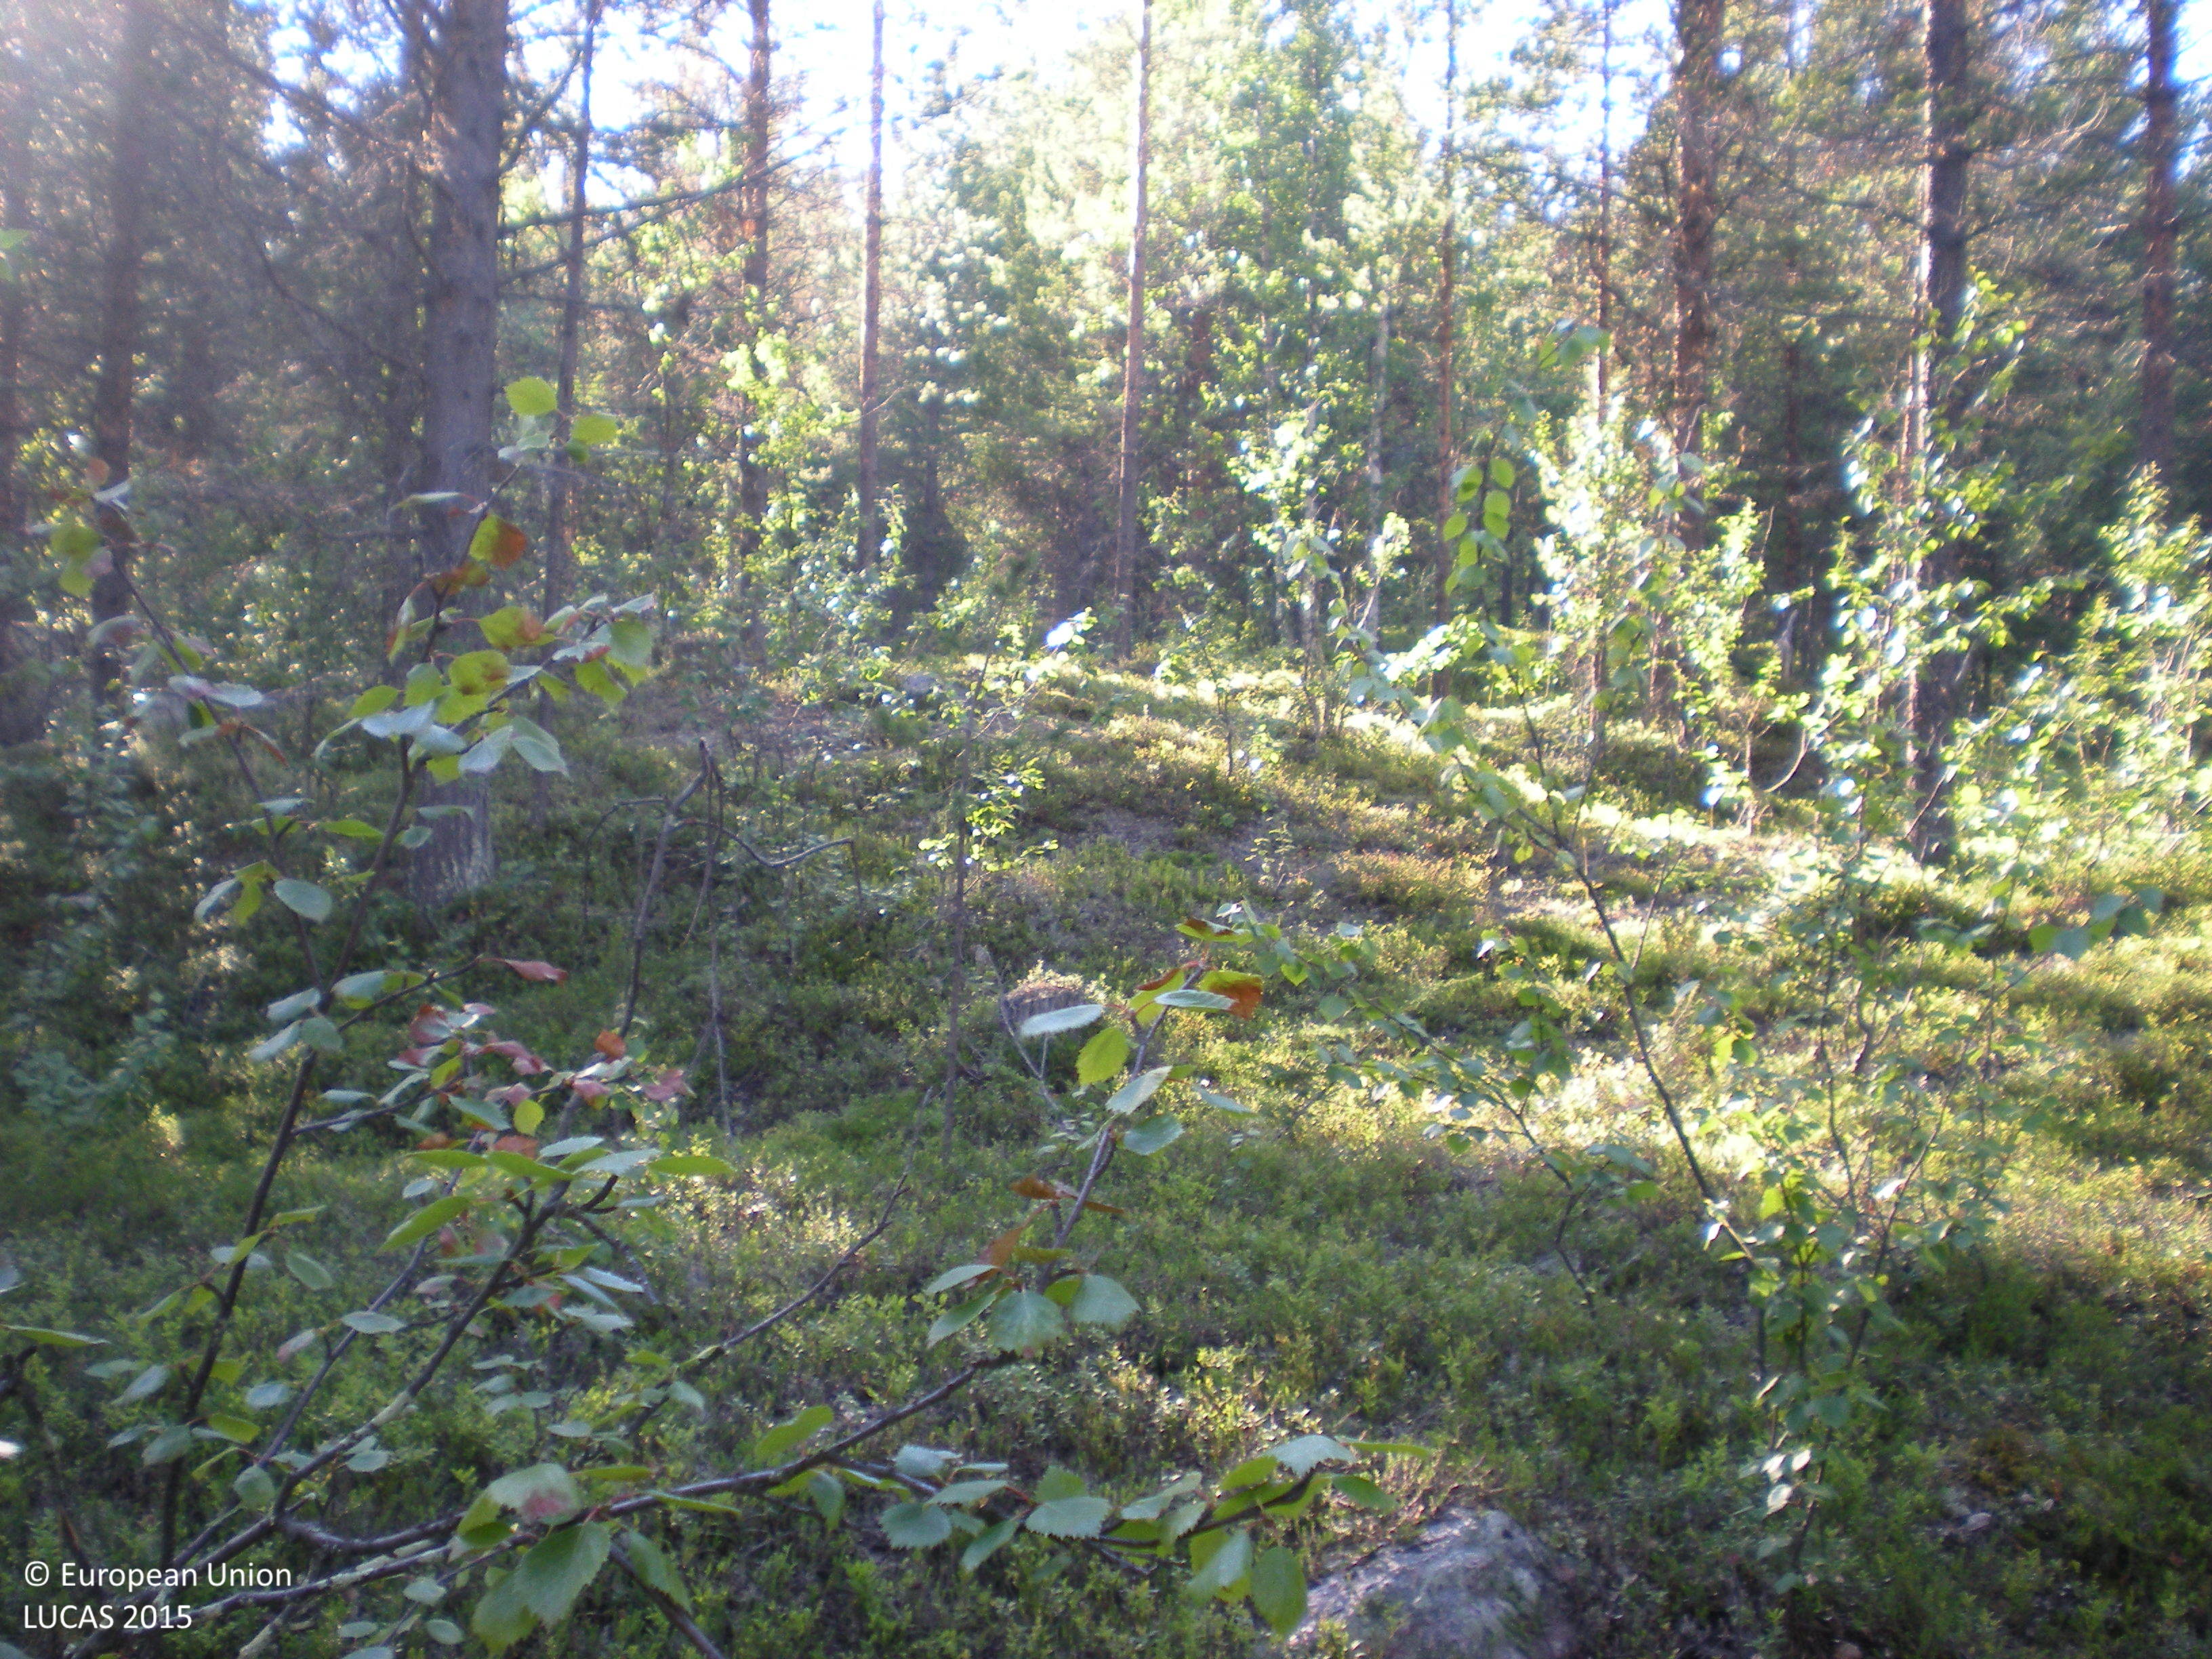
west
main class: Woodland
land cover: Pine dominated coniferous woodland
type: boreal forest
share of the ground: 50 - 75 %
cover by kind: coniferous forest trees 65 %, shrubs 25 %, broadleaved forest trees 5 %, lichens and mosses 5 %
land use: Forestry
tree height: > 5 m
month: August
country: SE
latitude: 66.3189
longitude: 18.0967
